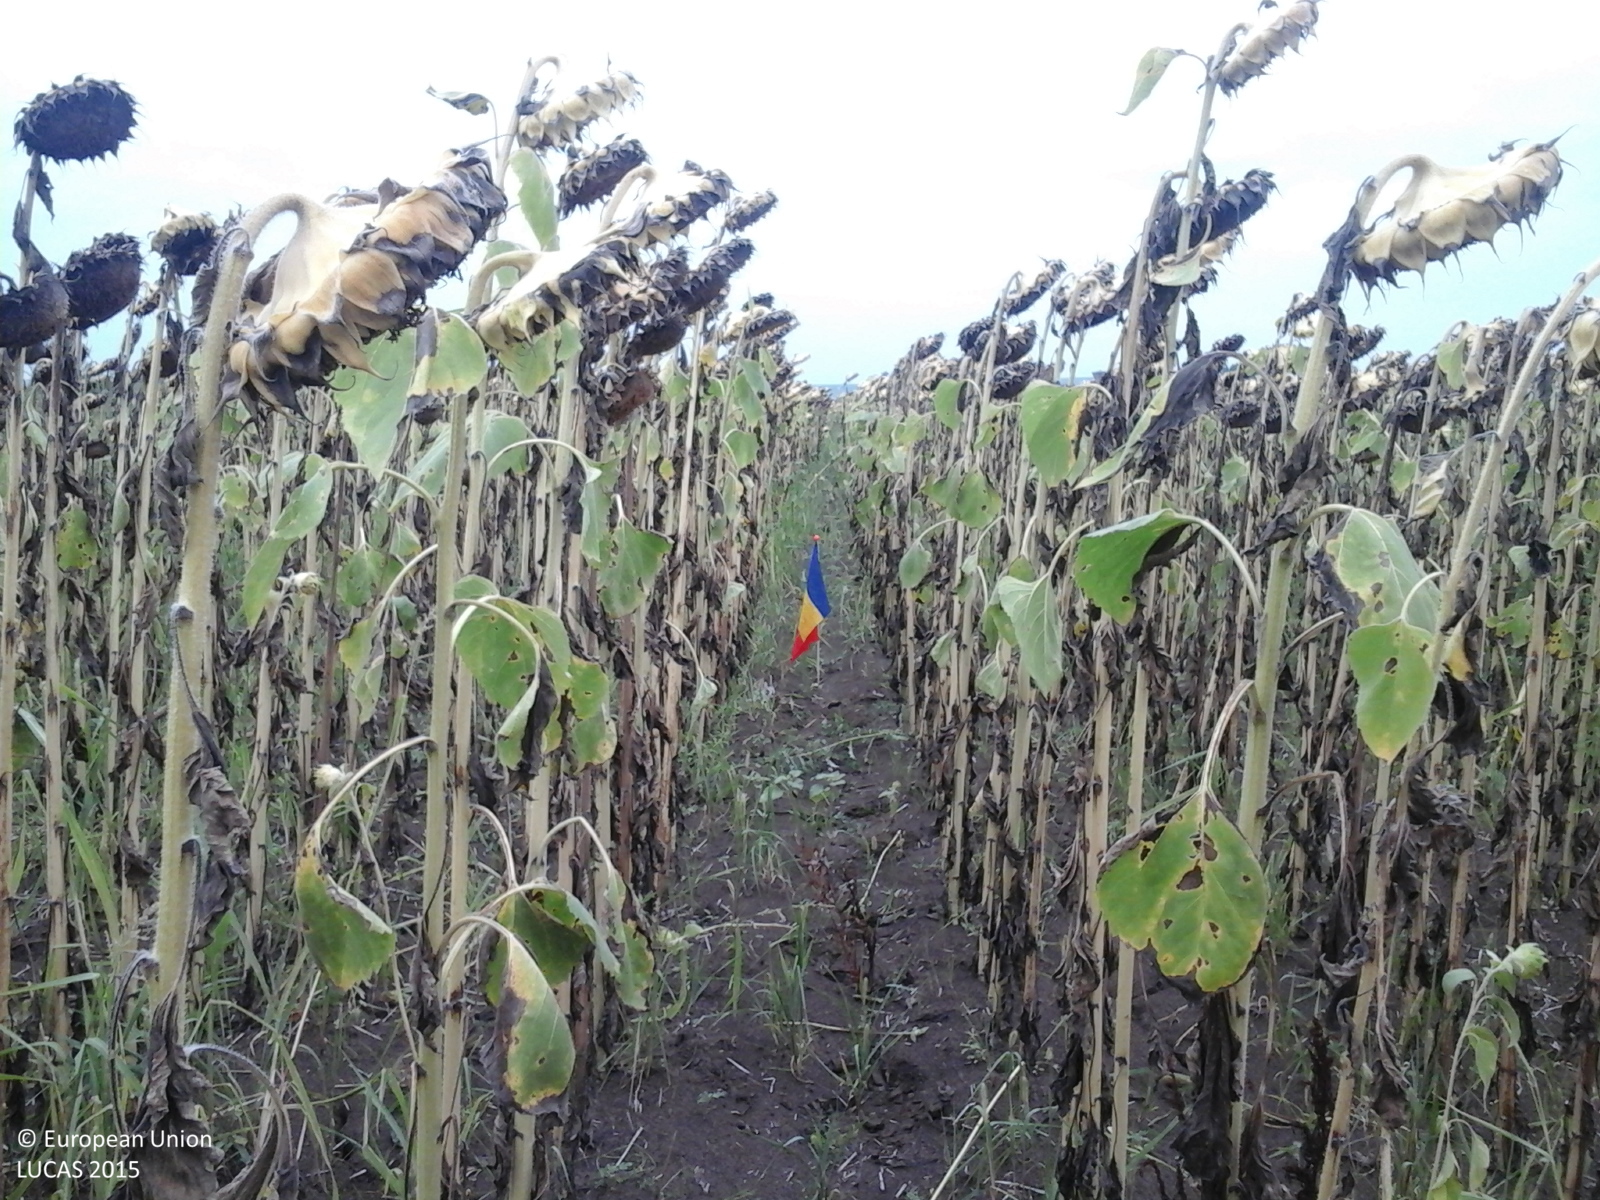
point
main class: Cropland
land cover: Sunflower
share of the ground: > 75 %
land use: Agriculture (excluding fallow land and kitchen gardens)
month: August
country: RO
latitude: 45.7839
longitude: 21.4943
